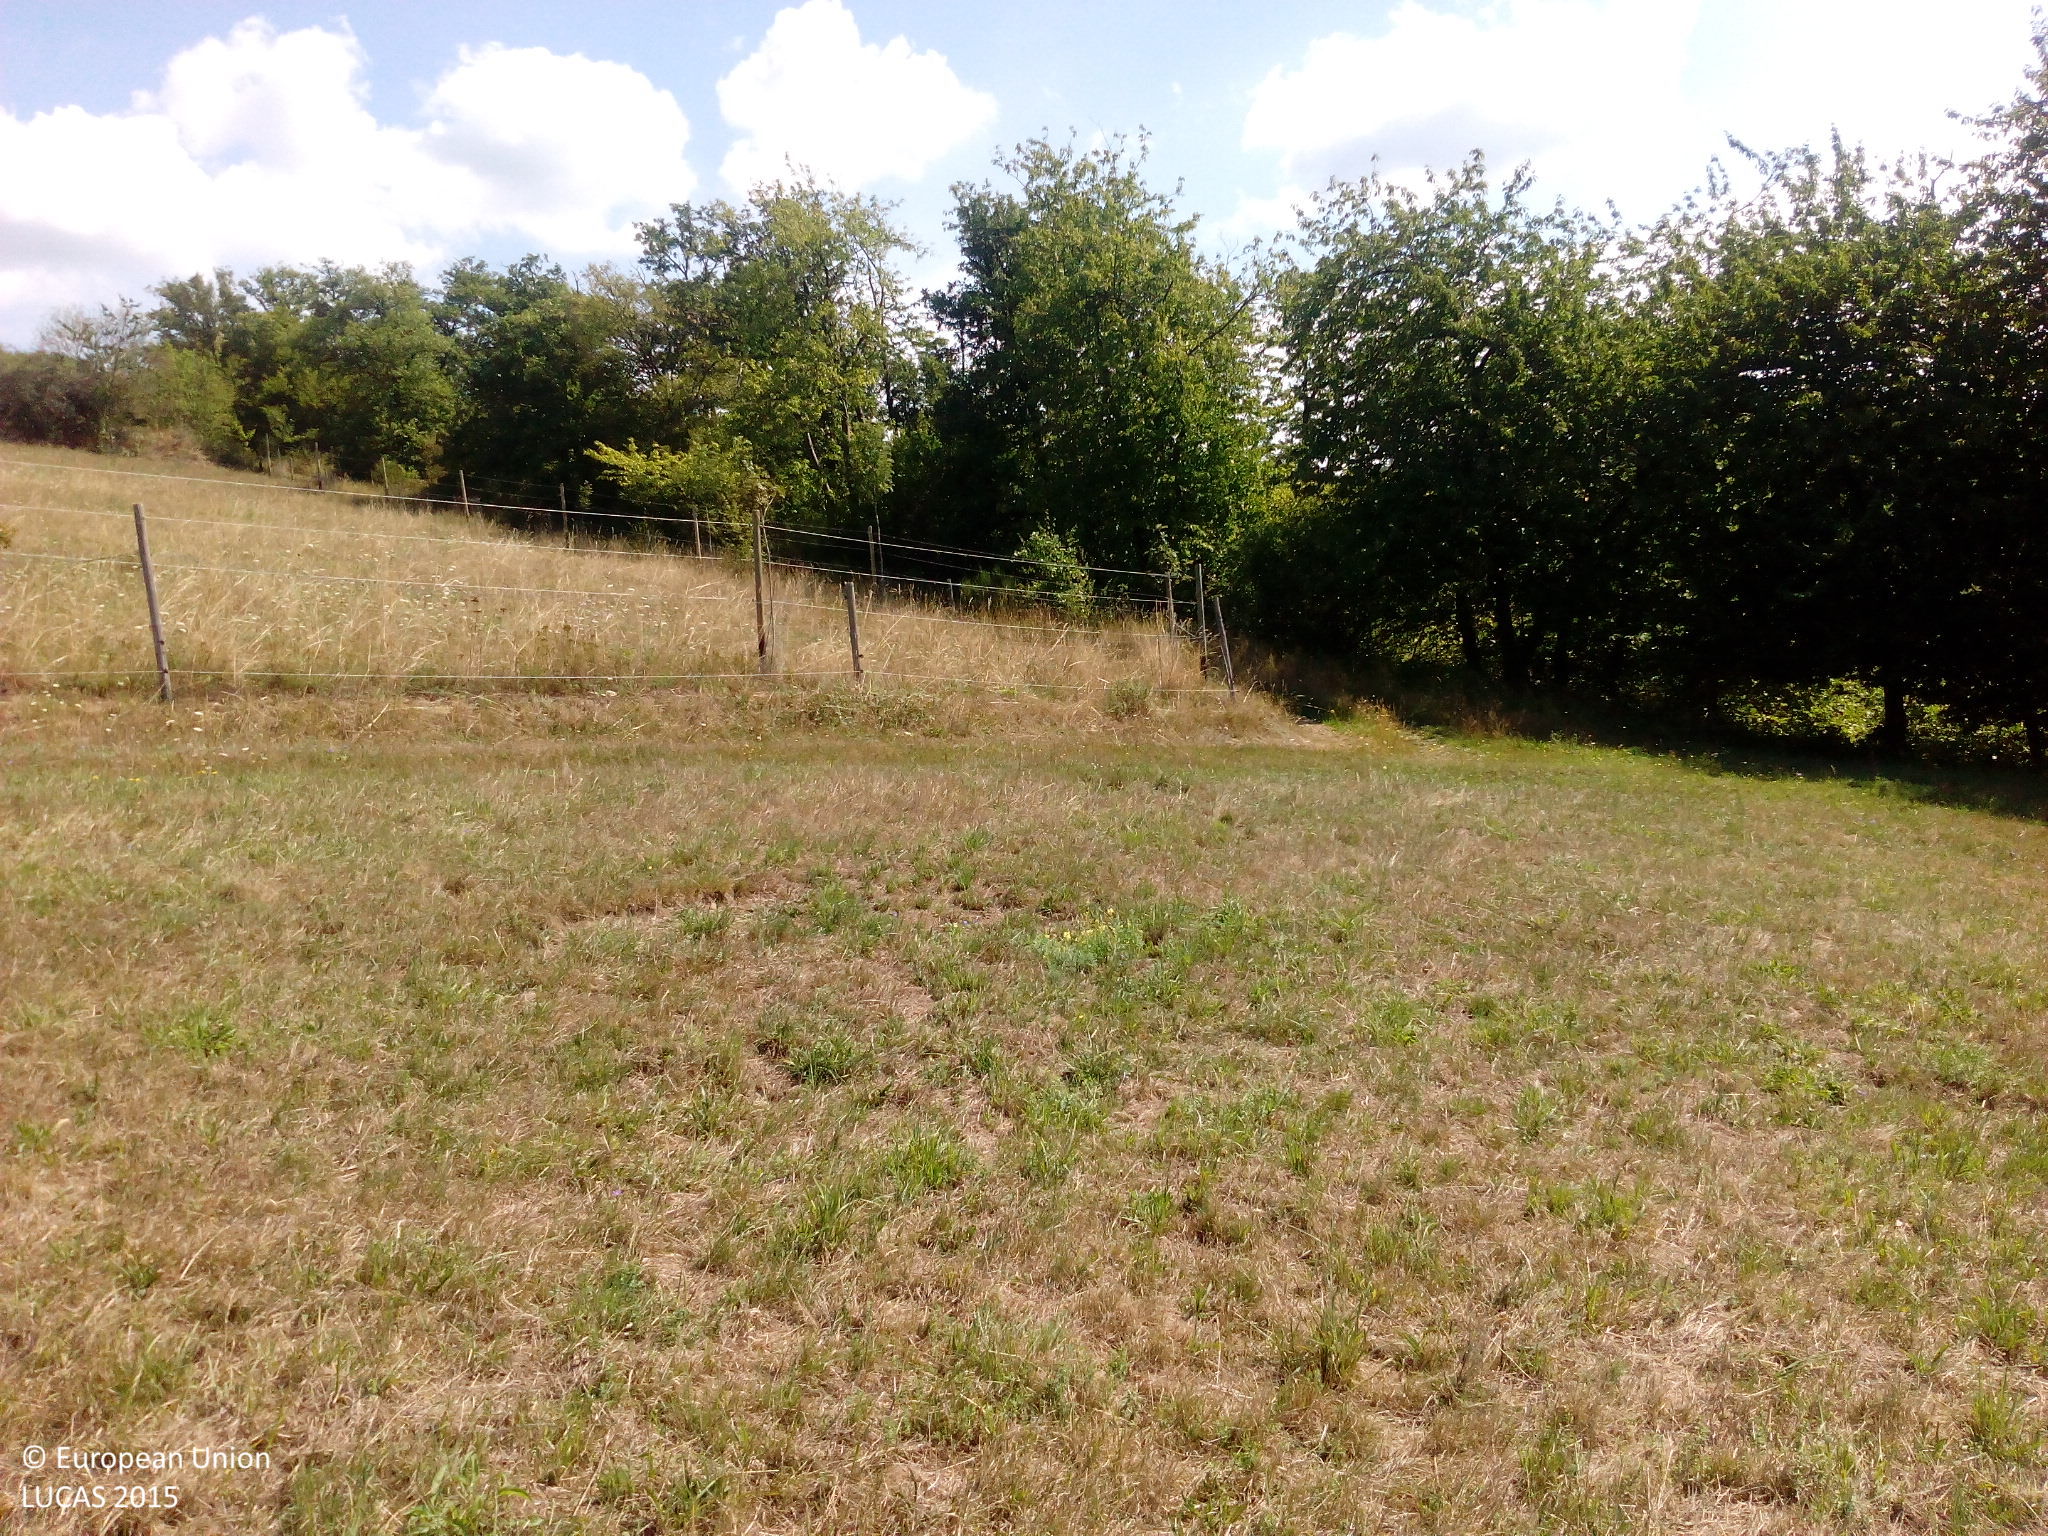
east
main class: Grassland
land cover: Grassland without tree/shrub cover
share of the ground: > 75 %
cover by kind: herbaceous plants 90 %, unconsolidated bare surface 10 %
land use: Agriculture (excluding fallow land and kitchen gardens)
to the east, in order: Grassland without tree/shrub cover; Tracks; Fences; Lines of trees; Fences; Grassland without tree/shrub cover; Fences; Lines of trees; Fences; Tracks; Broadleaved woodland
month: August
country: DE
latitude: 50.2280
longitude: 7.4631
